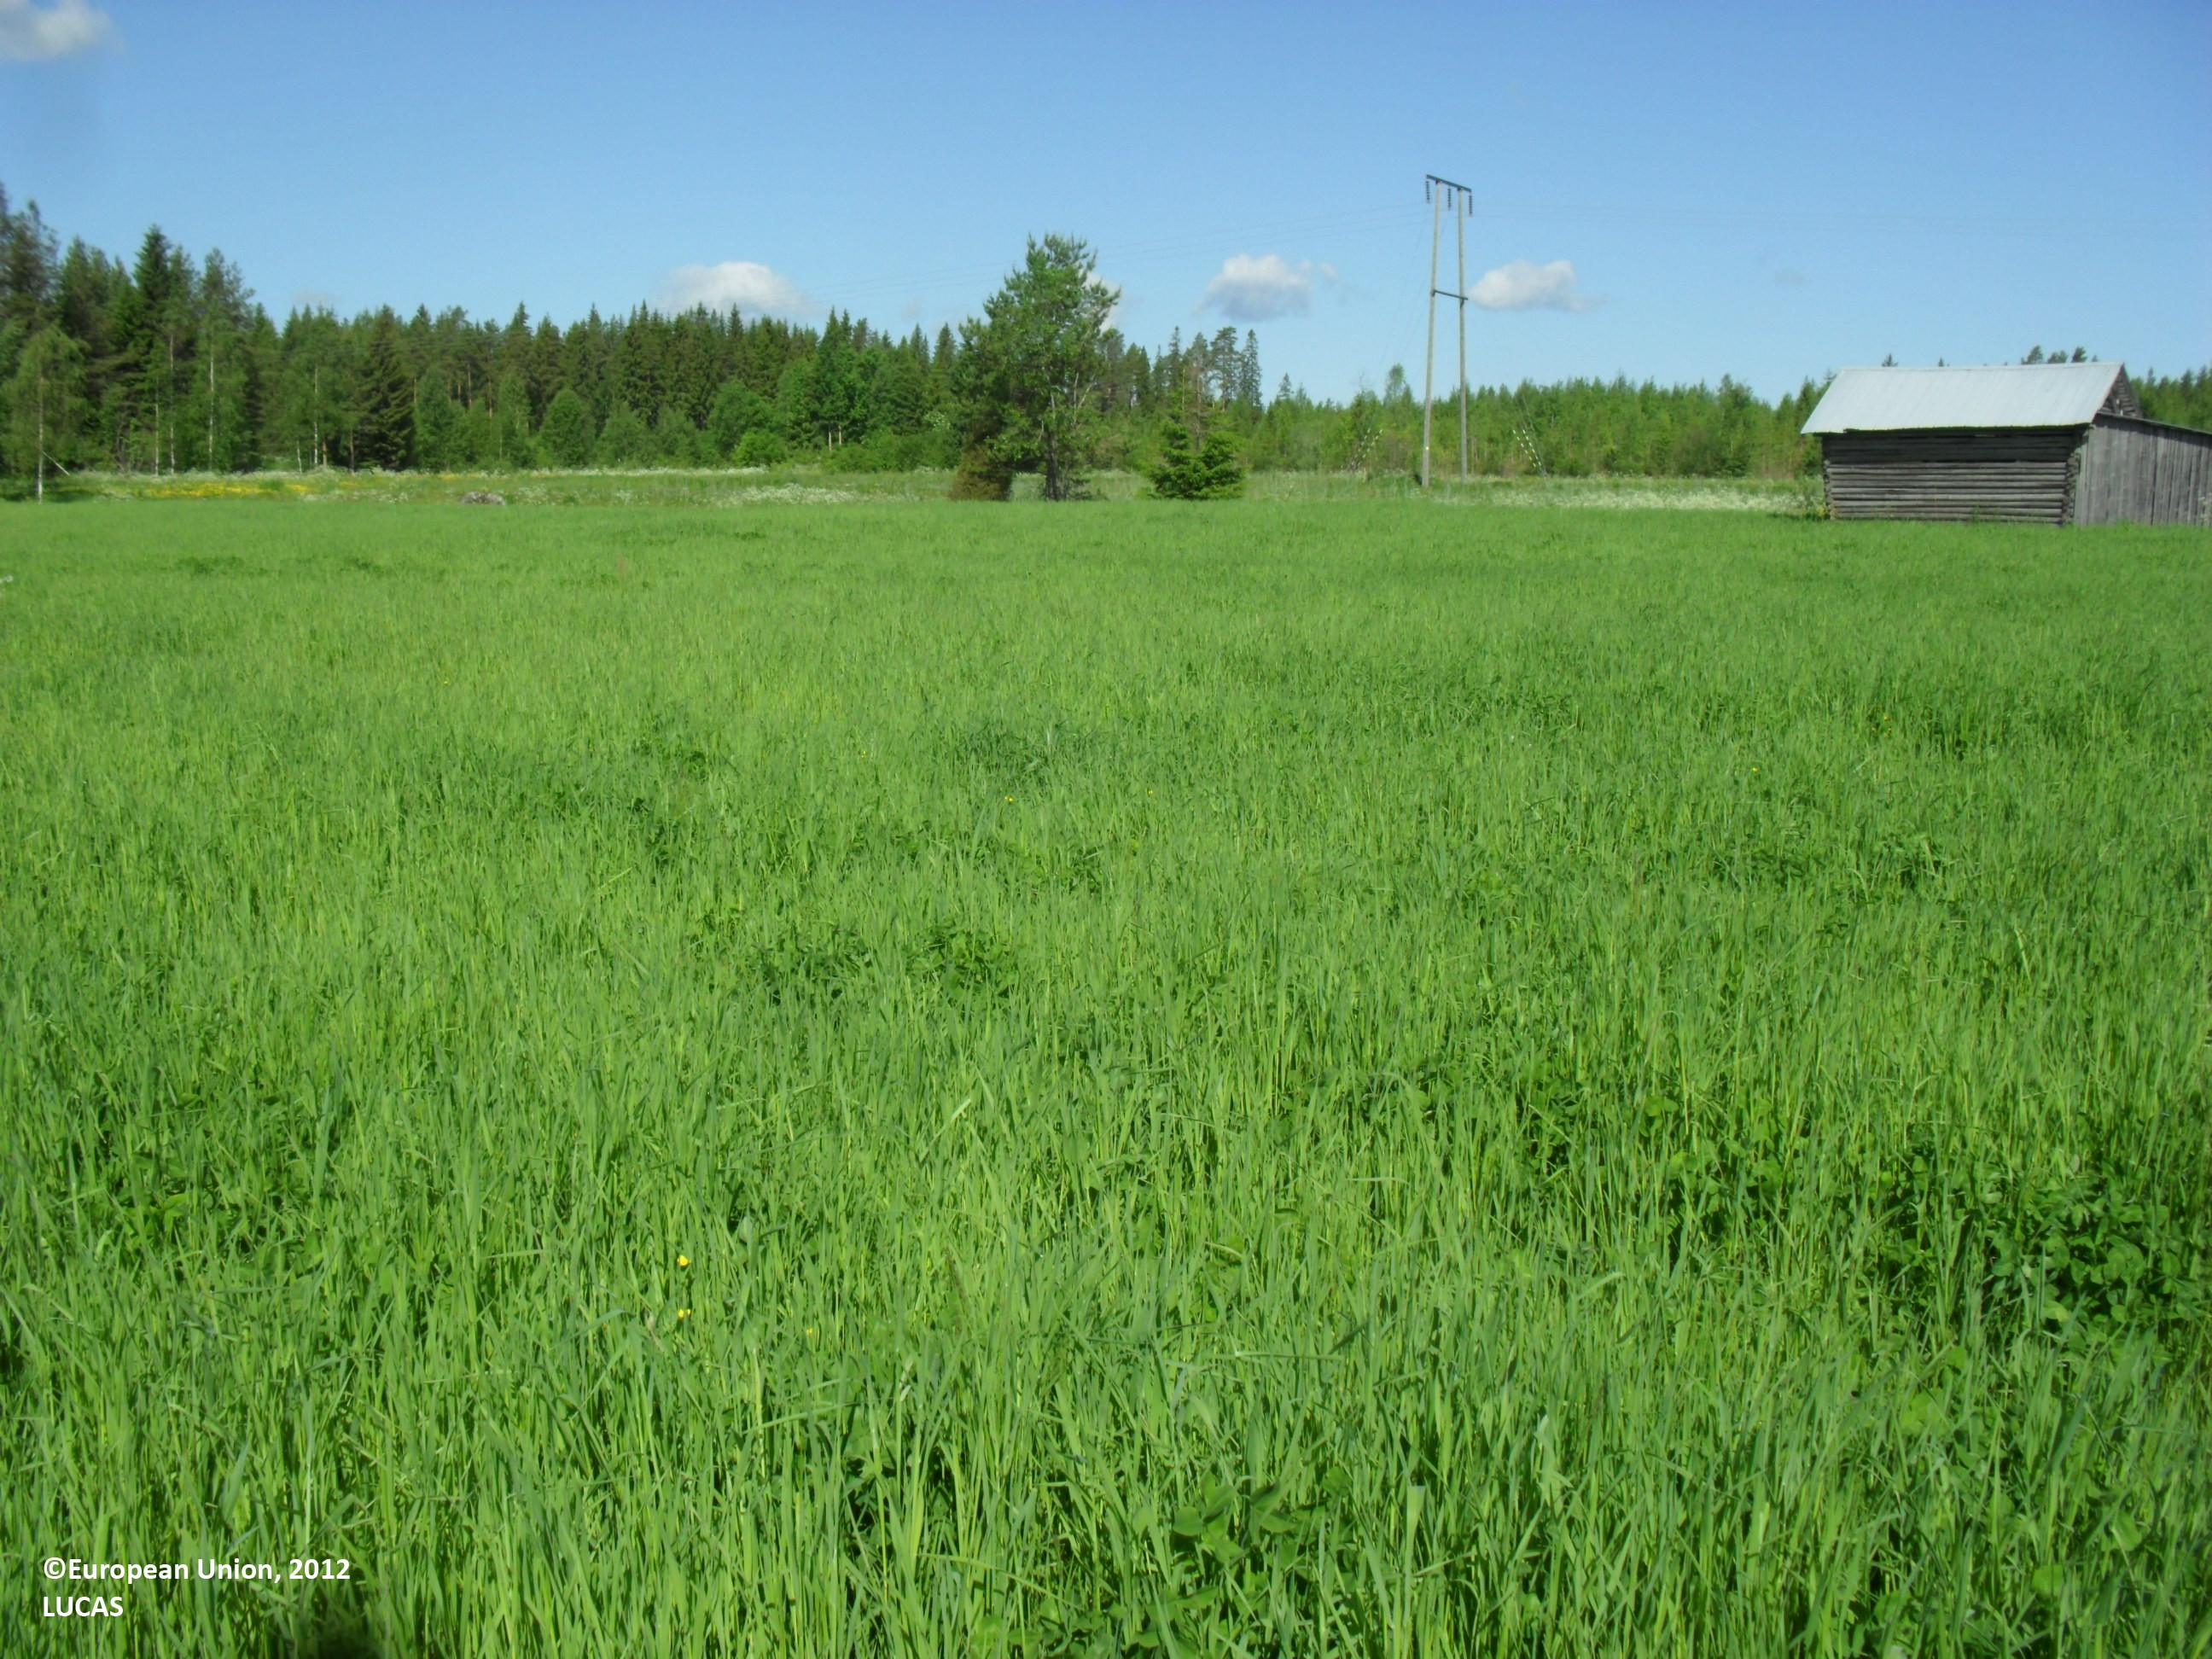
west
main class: Cropland
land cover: Temporary grasslands
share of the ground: > 75 %
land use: Agriculture (excluding fallow land and kitchen gardens)
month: June
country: FI
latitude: 62.9685
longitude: 23.1371
